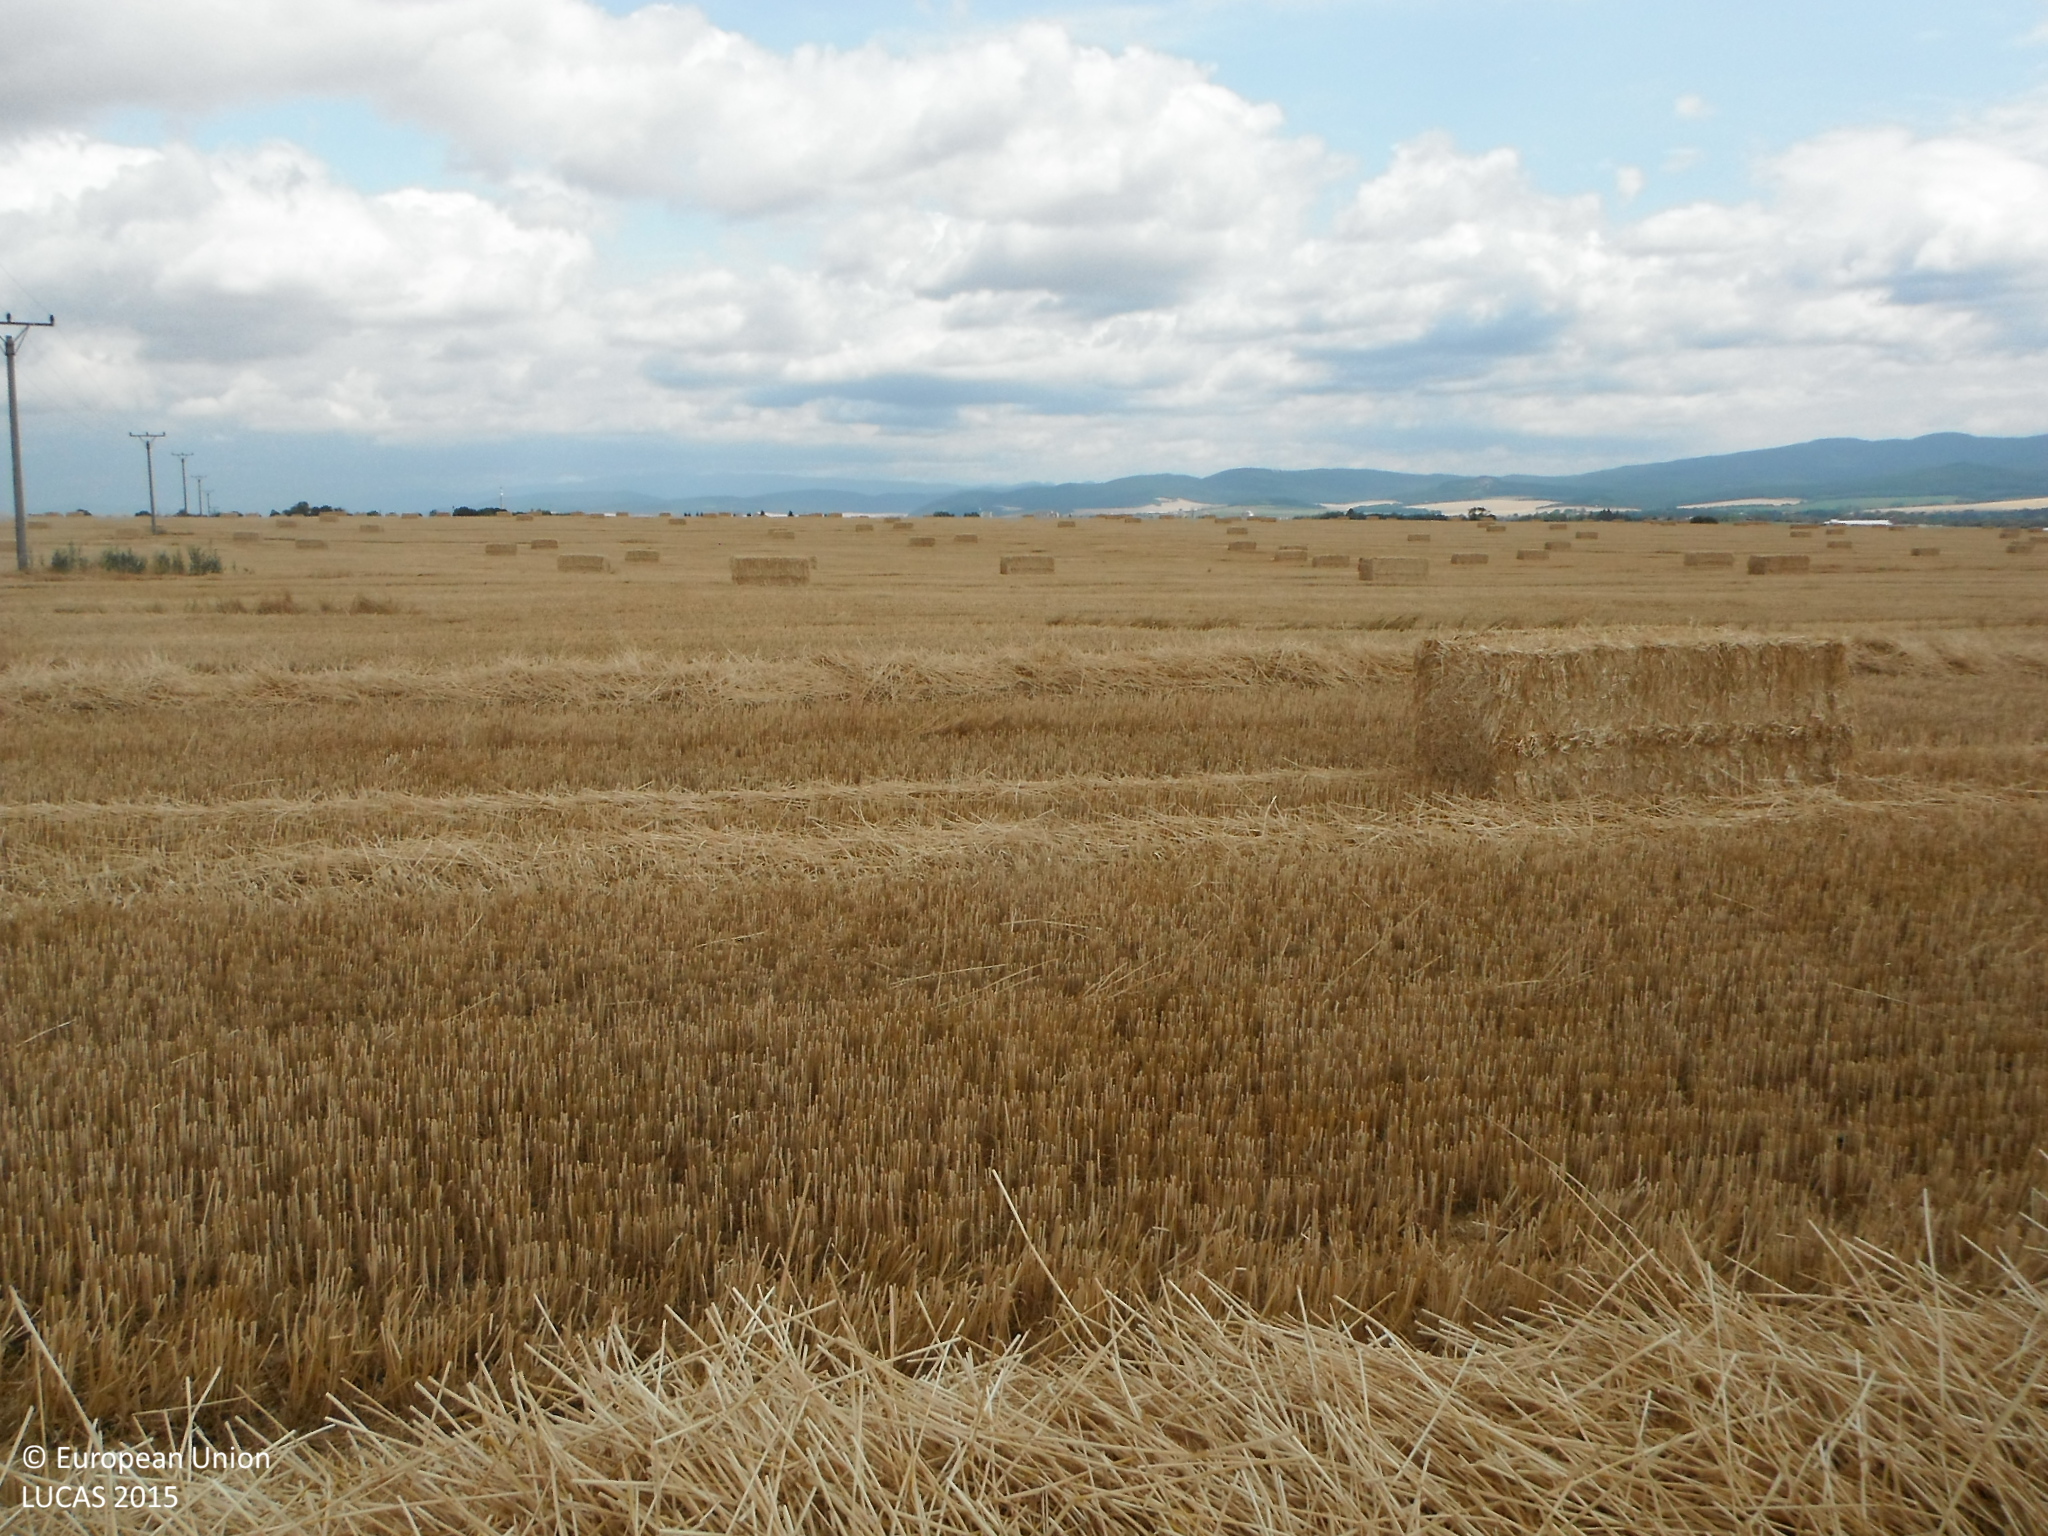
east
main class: Cropland
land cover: Common wheat
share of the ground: > 75 %
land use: Agriculture (excluding fallow land and kitchen gardens)
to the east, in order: Common wheat
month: July
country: SK
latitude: 48.5558
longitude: 18.1301
